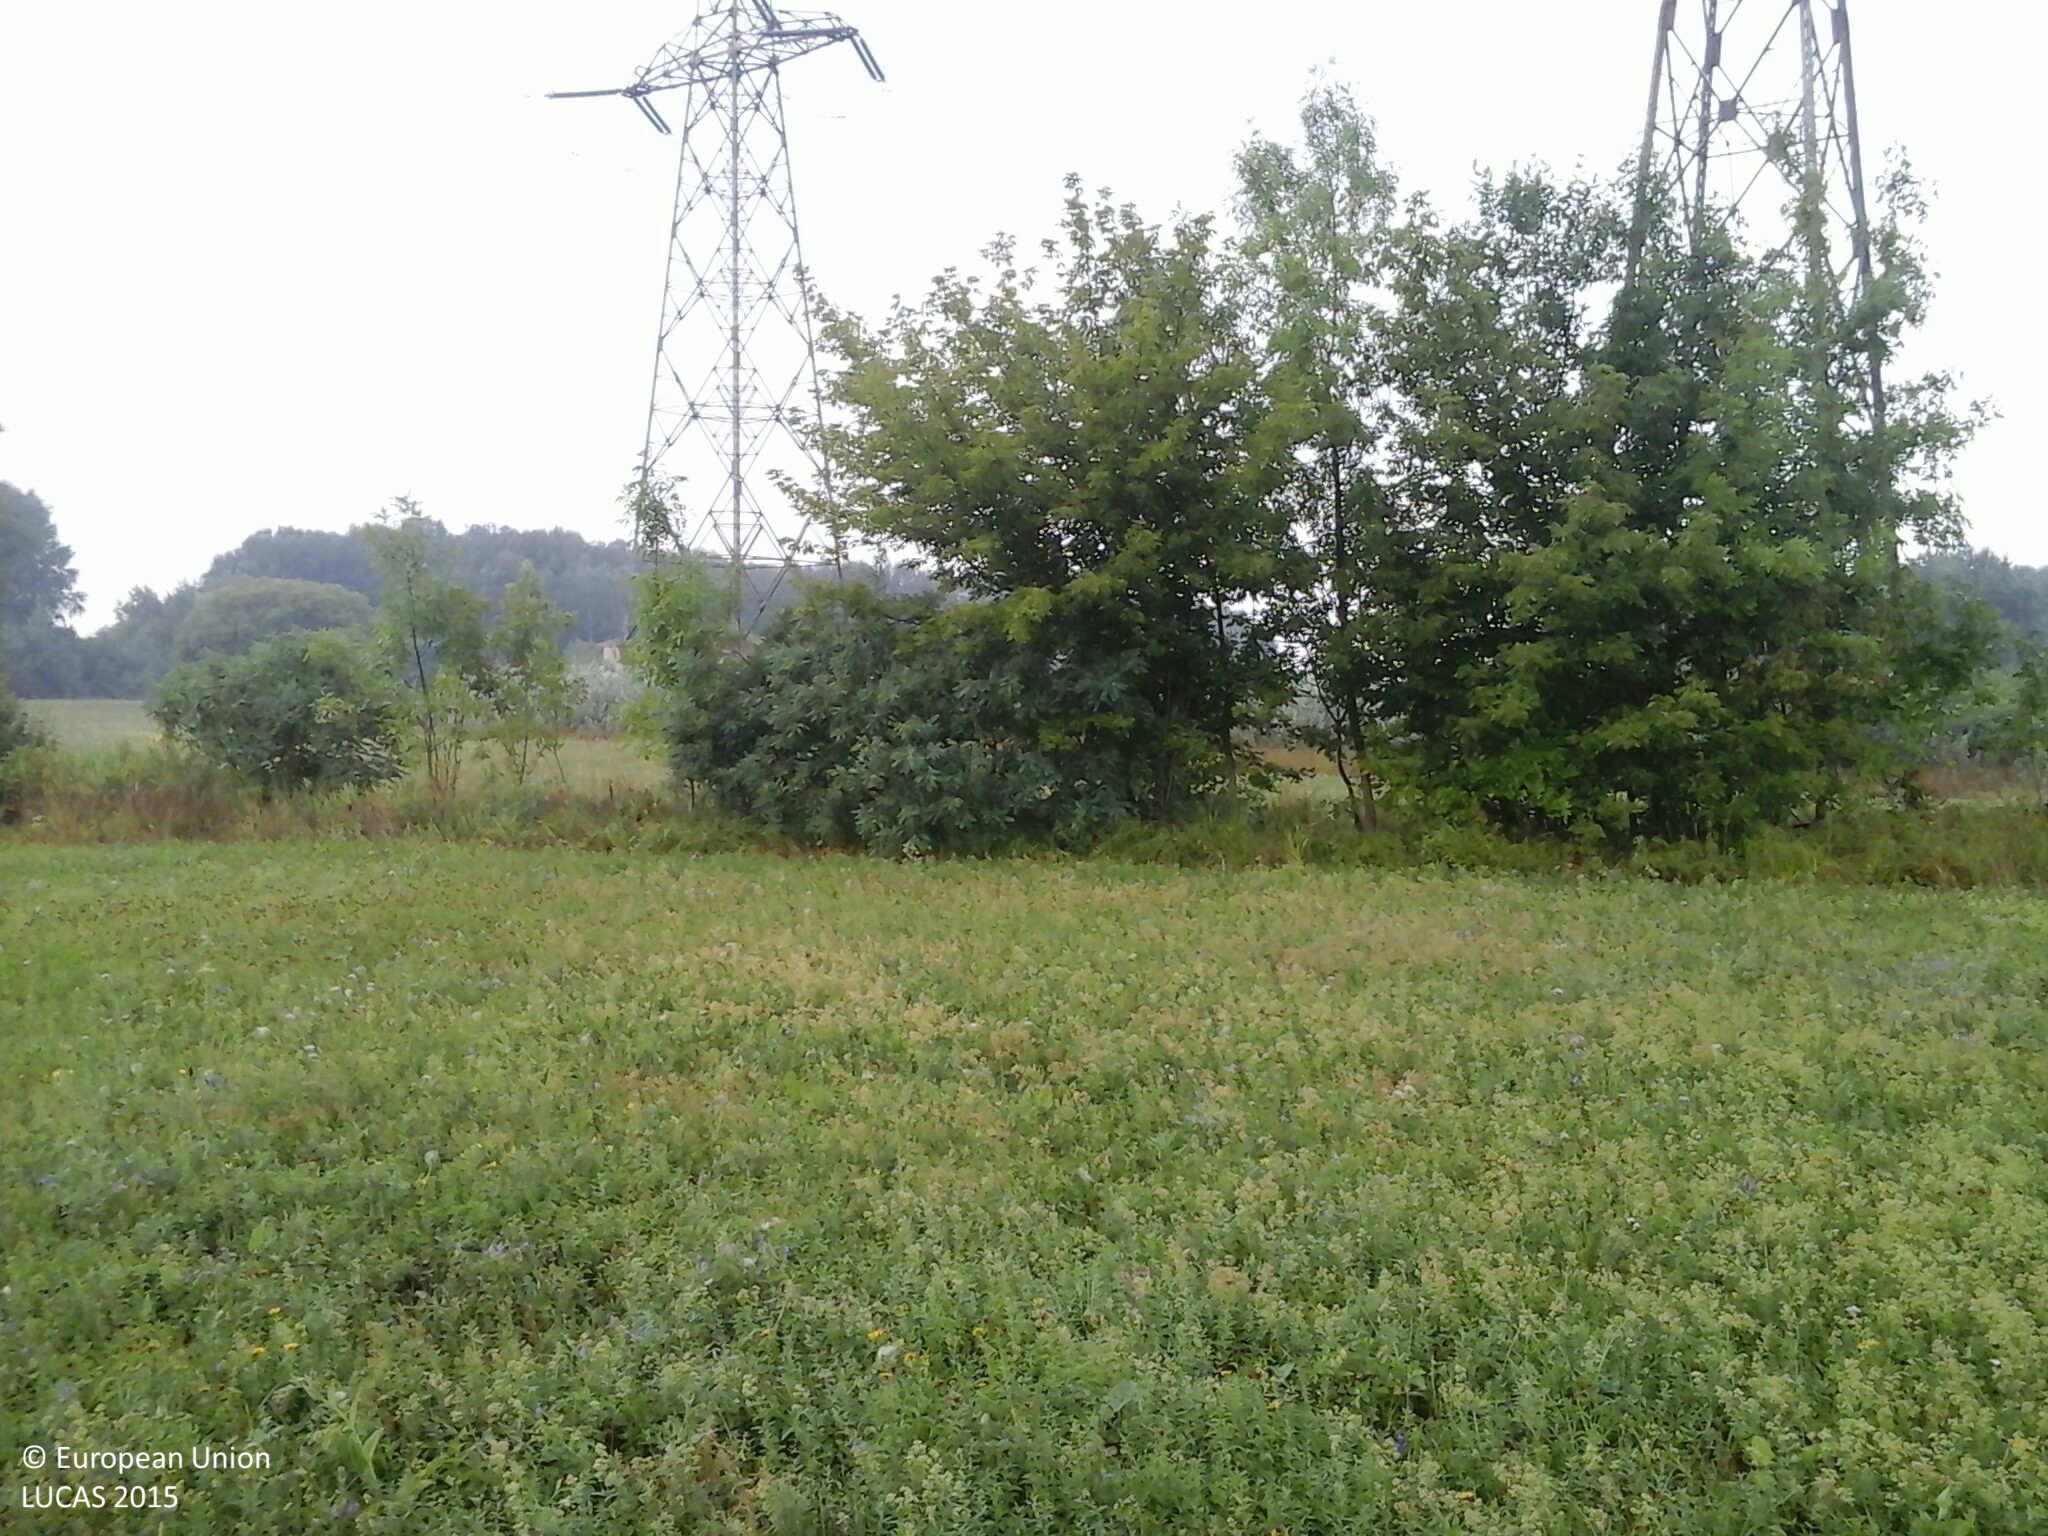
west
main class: Grassland
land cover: Grassland with sparse tree/shrub cover
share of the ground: > 75 %
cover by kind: herbaceous plants 85 %, shrubs 10 %, broadleaved forest trees 5 %
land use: Agriculture (excluding fallow land and kitchen gardens)
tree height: > 5 m
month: August
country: HU
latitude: 47.9353
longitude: 21.0829
